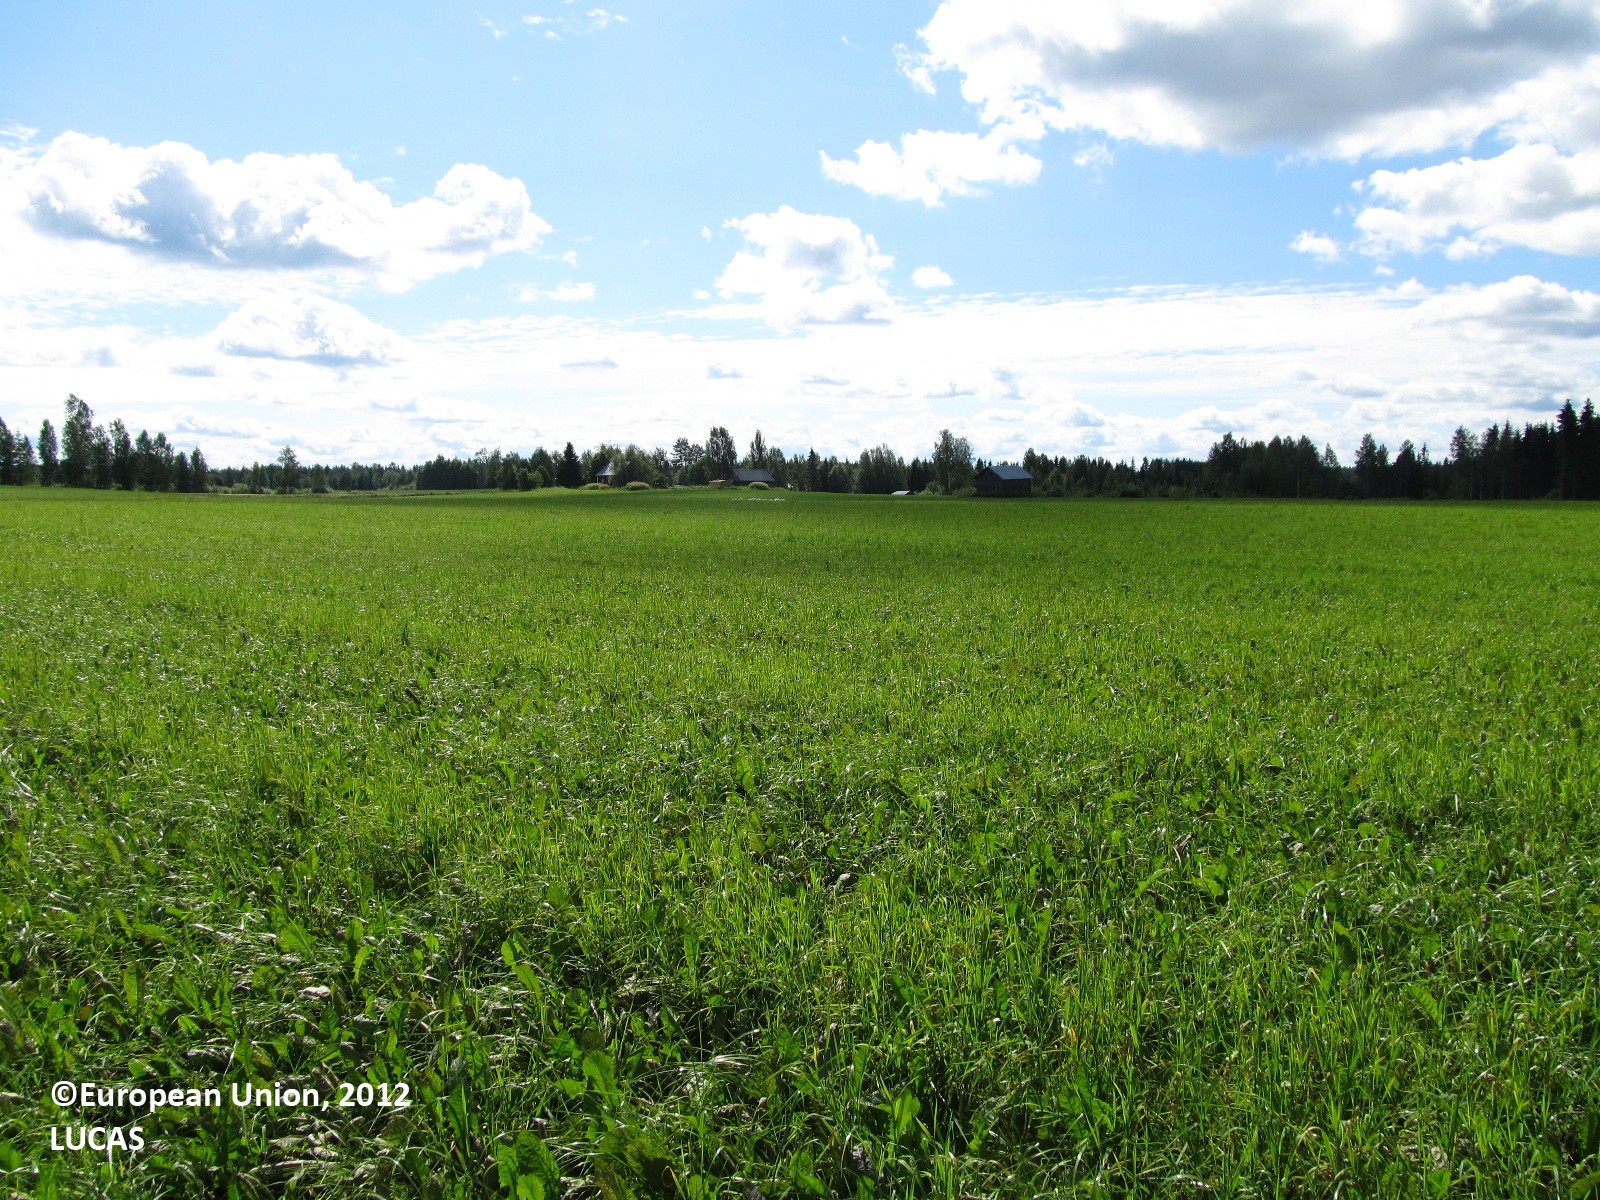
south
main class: Cropland
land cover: Temporary grasslands
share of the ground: 50 - 75 %
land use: Agriculture (excluding fallow land and kitchen gardens)
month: July
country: FI
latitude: 62.0567
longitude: 27.9583
